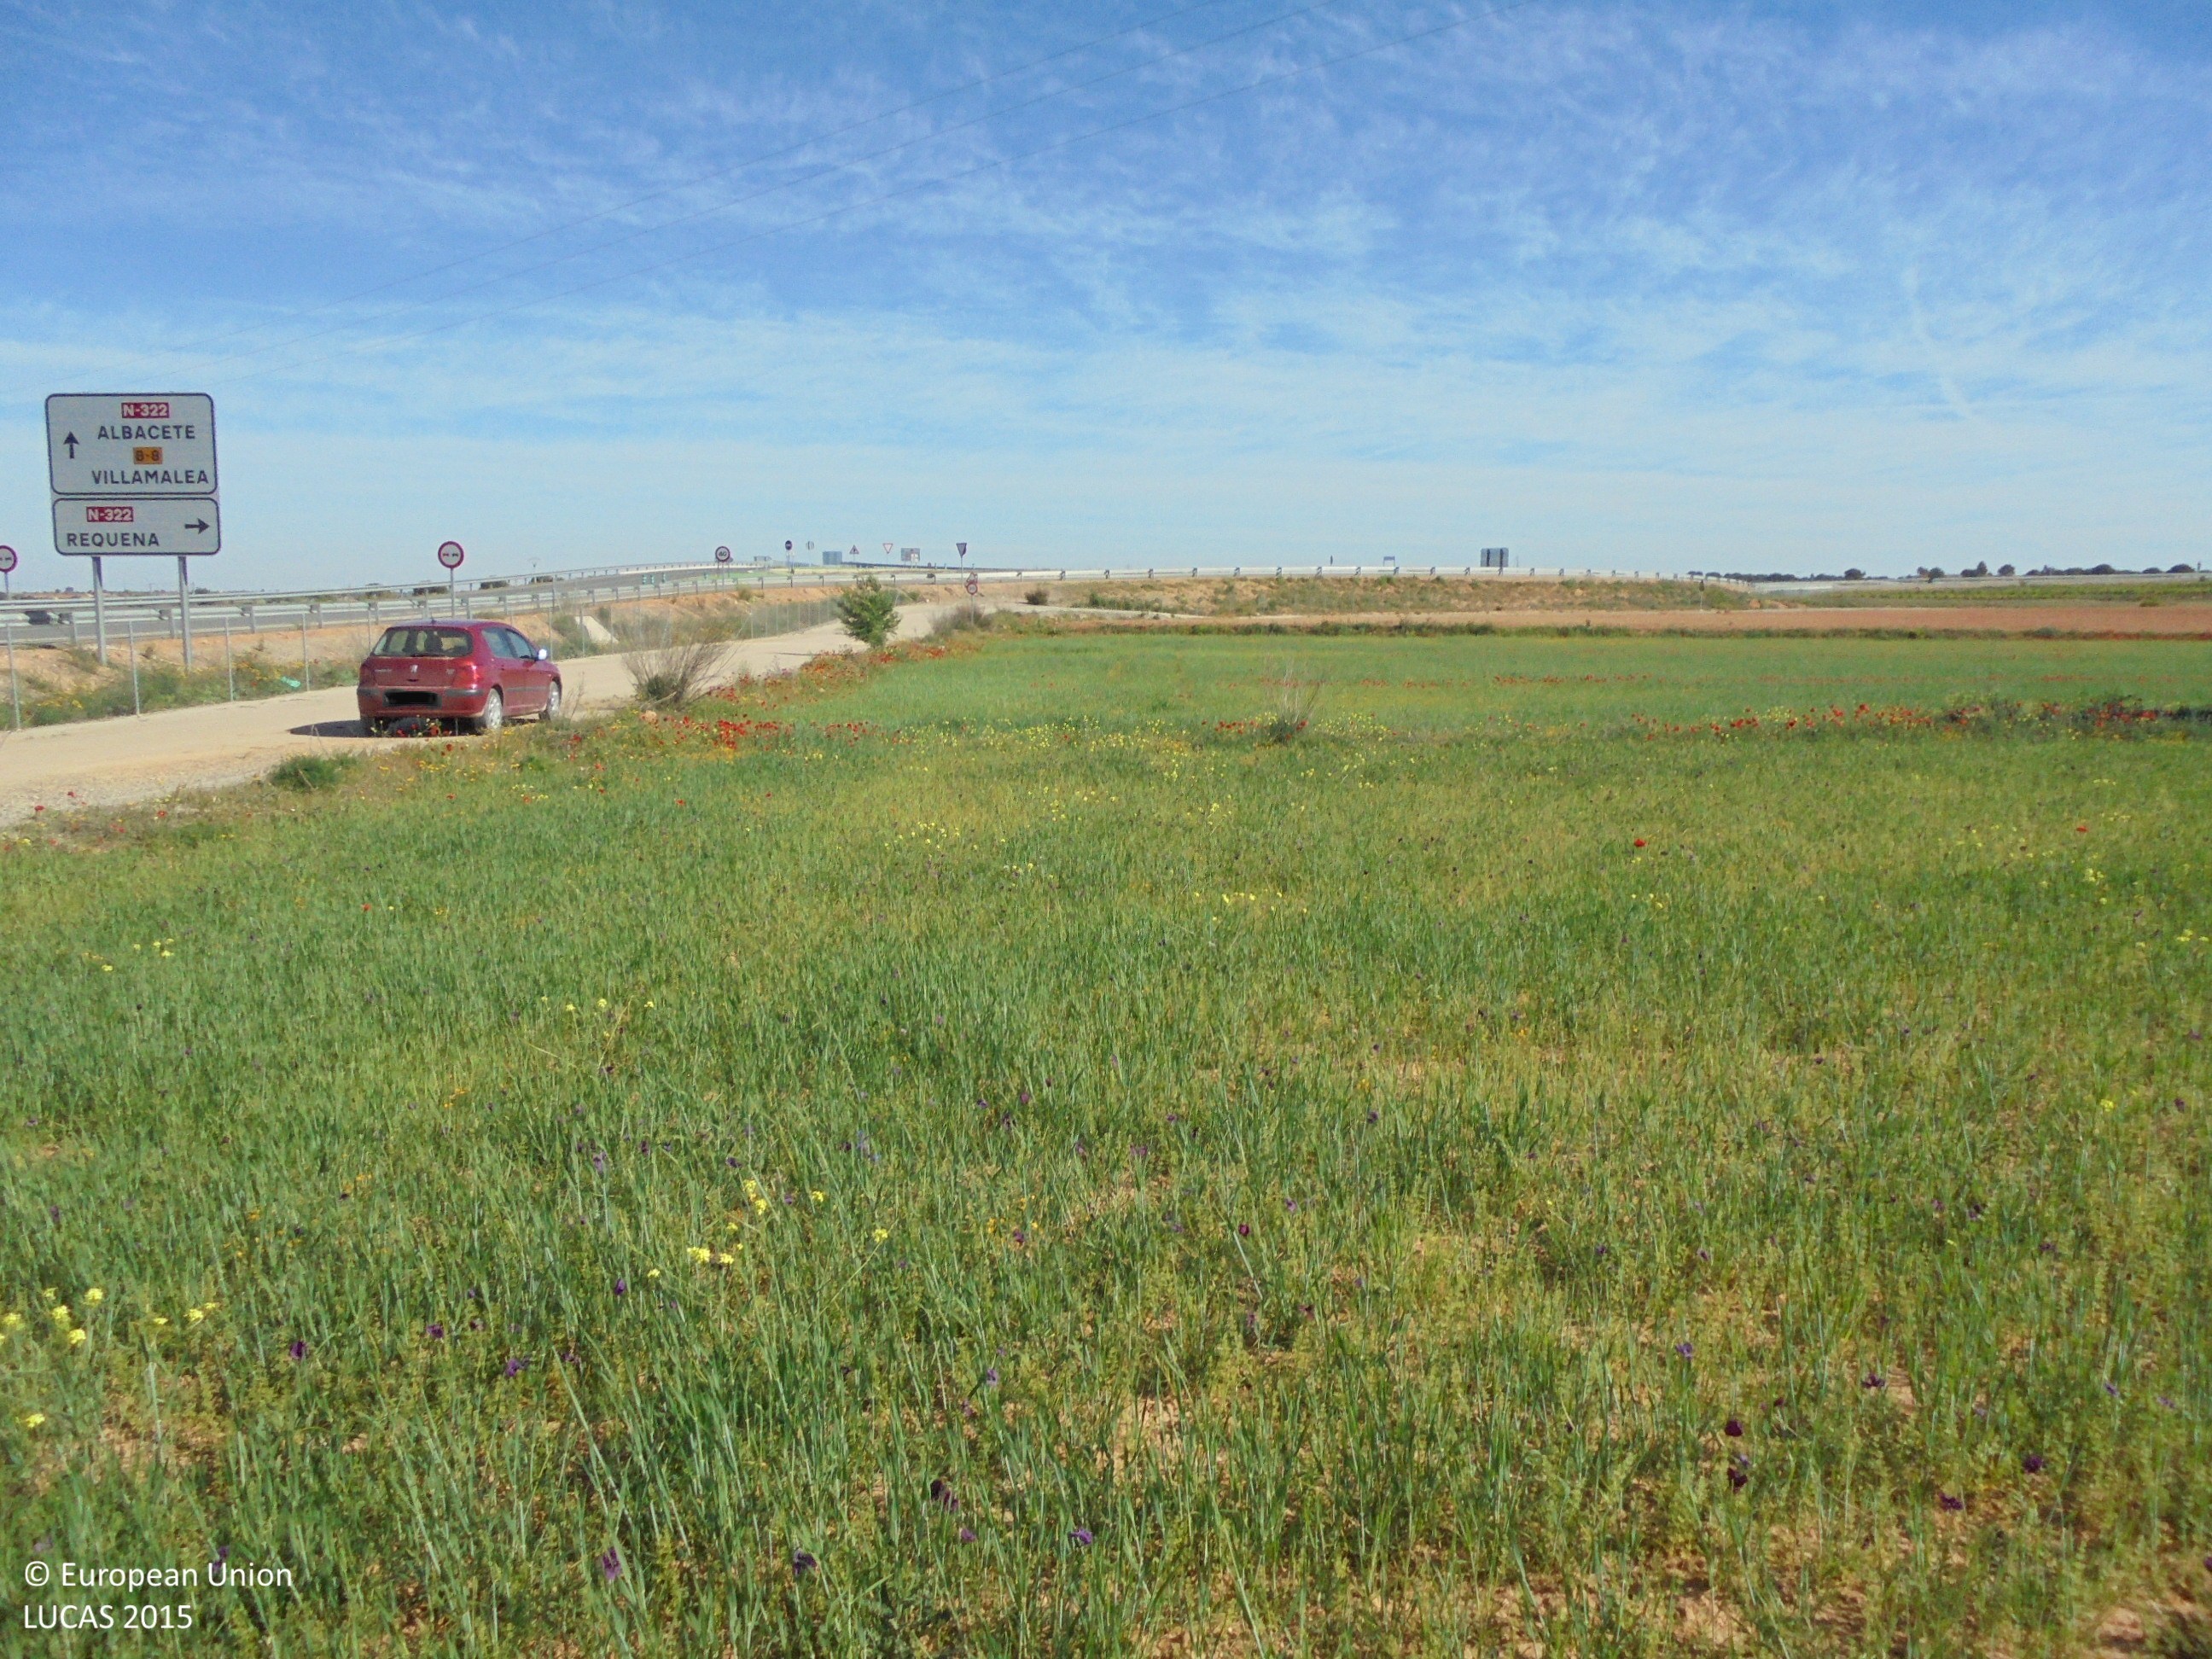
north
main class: Cropland
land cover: Barley
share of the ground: 25 - 50 %
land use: Agriculture (excluding fallow land and kitchen gardens)
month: May
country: ES
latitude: 39.2713
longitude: -1.5580
